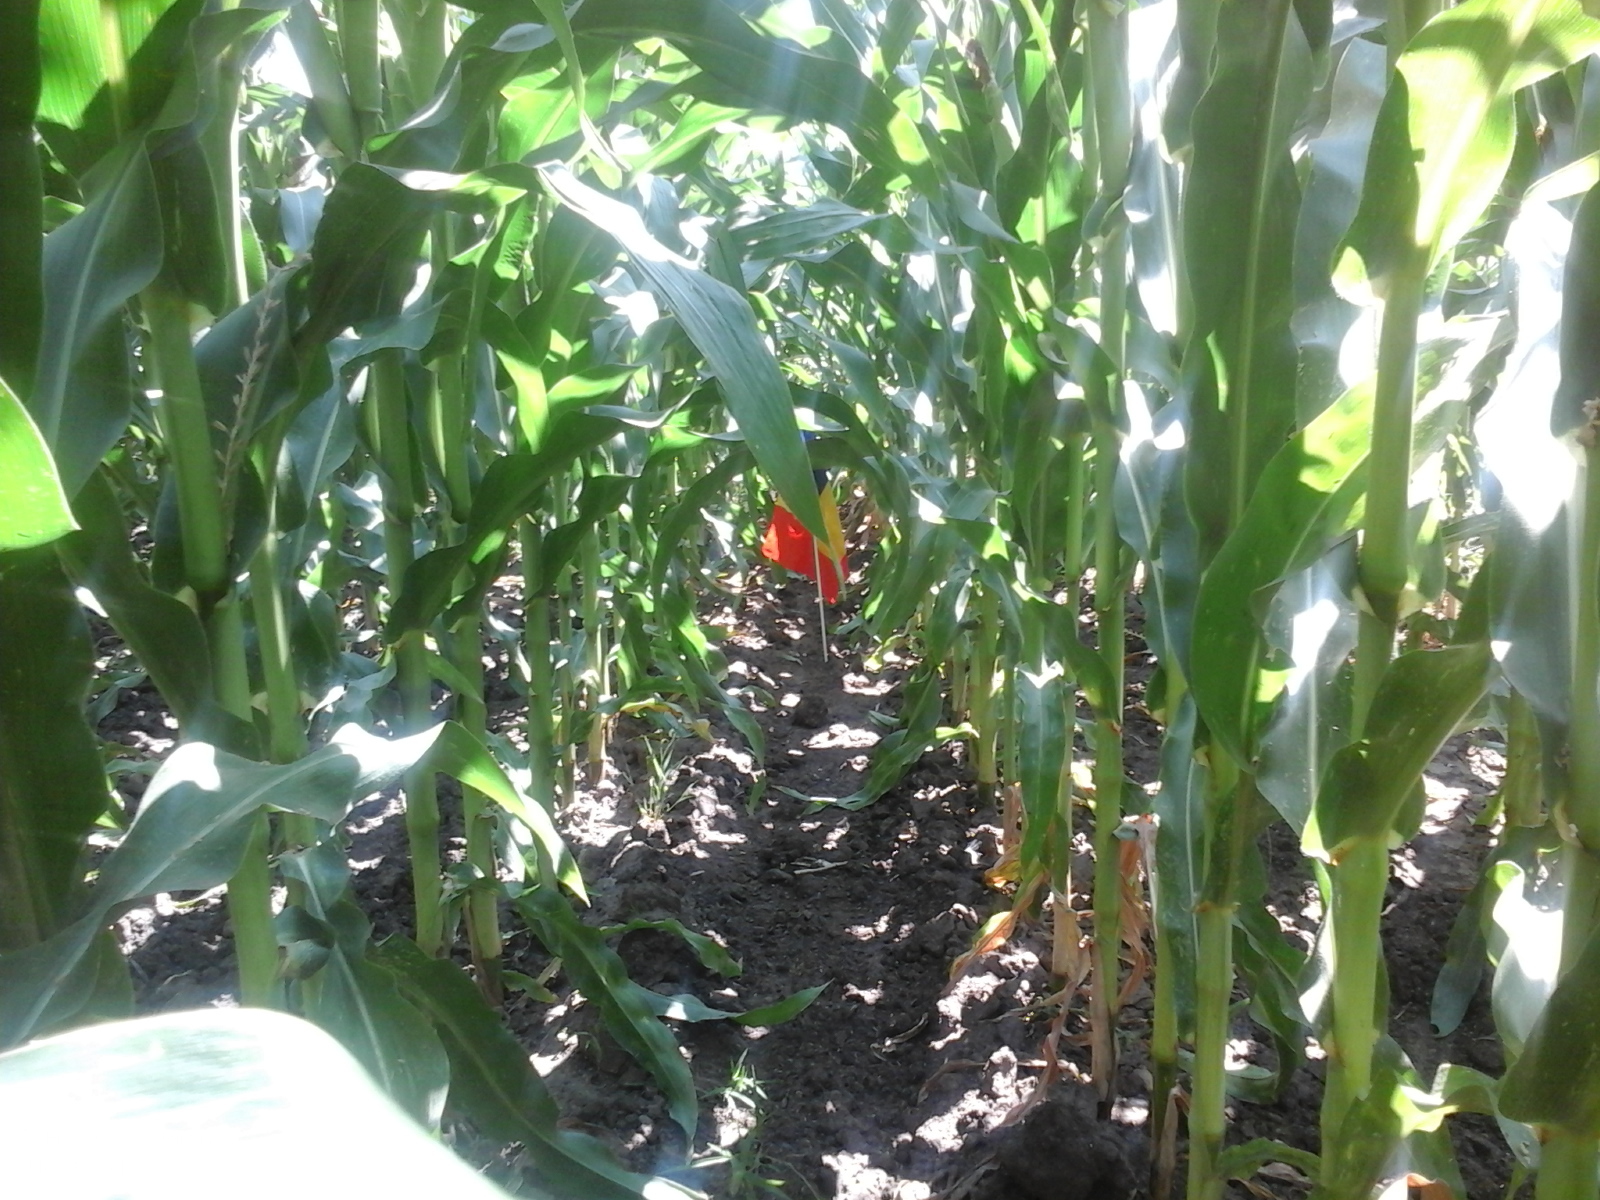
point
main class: Cropland
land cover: Maize
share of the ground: > 75 %
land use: Agriculture (excluding fallow land and kitchen gardens)
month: July
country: RO
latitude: 44.5188
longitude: 27.1037
